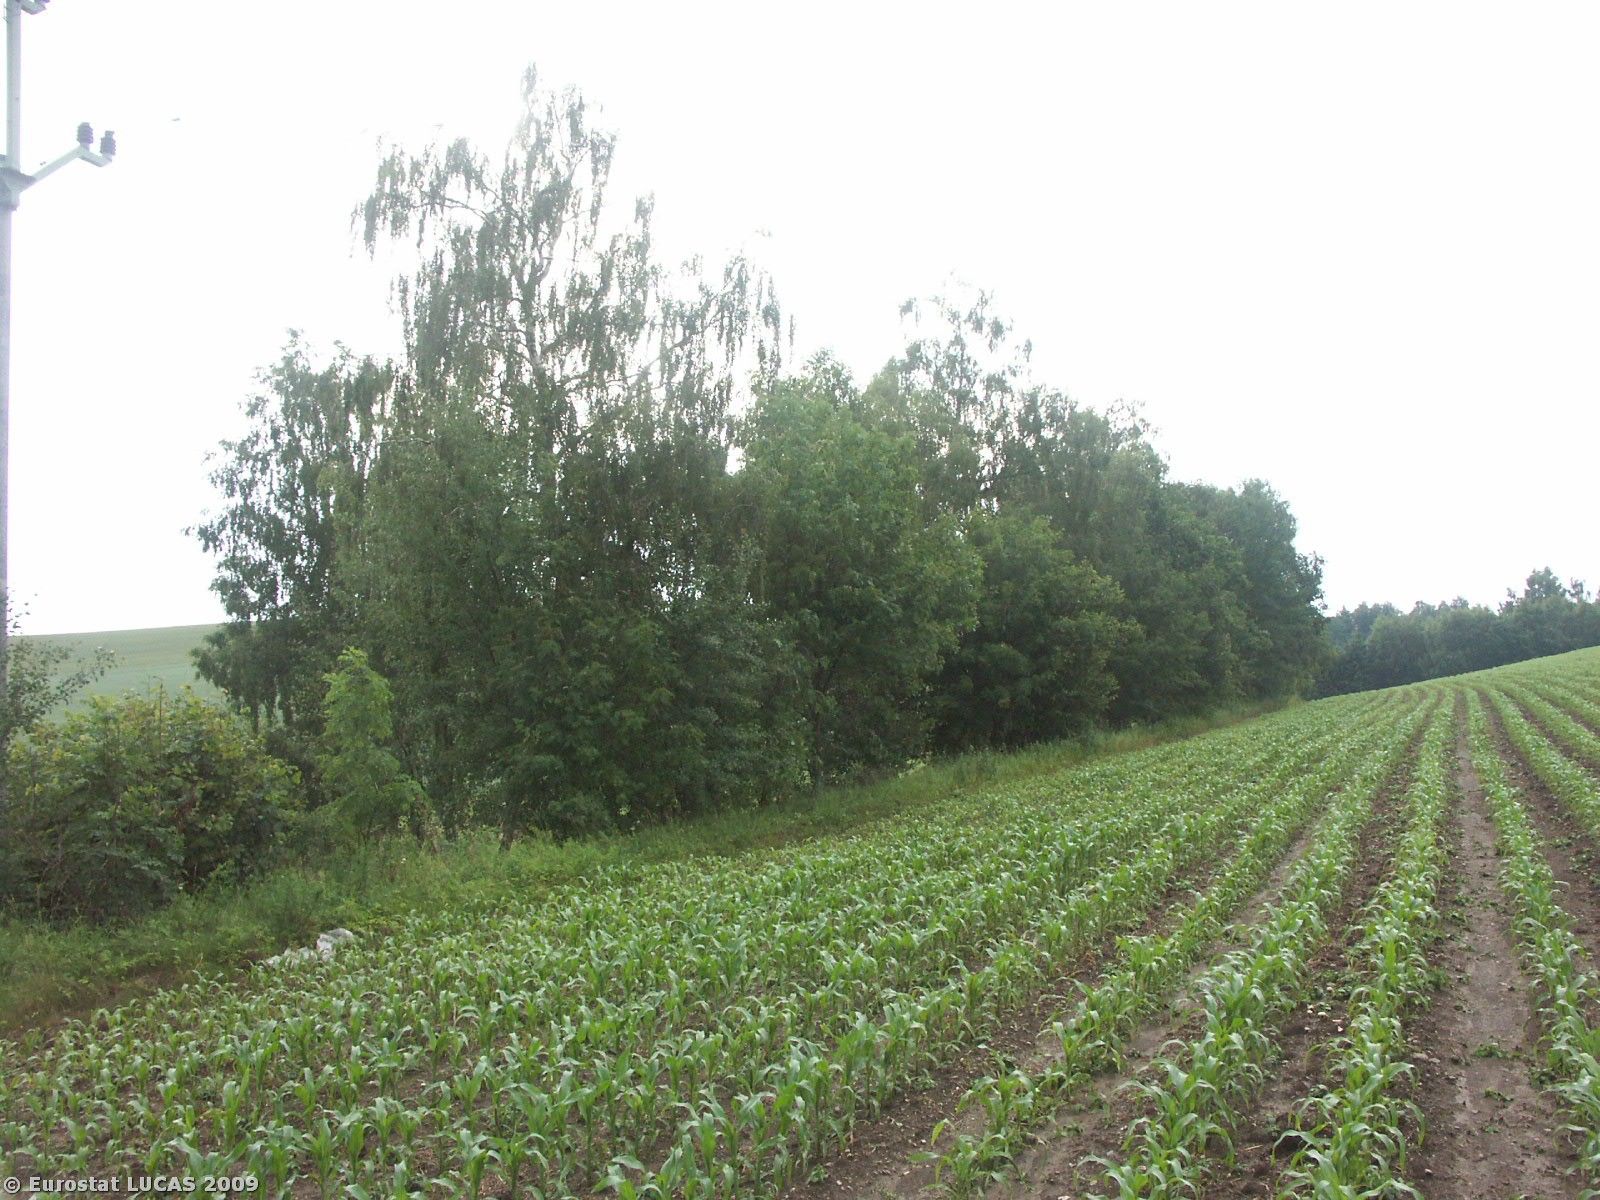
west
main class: Cropland
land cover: Maize
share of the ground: 10 - 25 %
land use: Agriculture (excluding fallow land and kitchen gardens)
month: July
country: CZ
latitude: 49.9894
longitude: 16.6614
